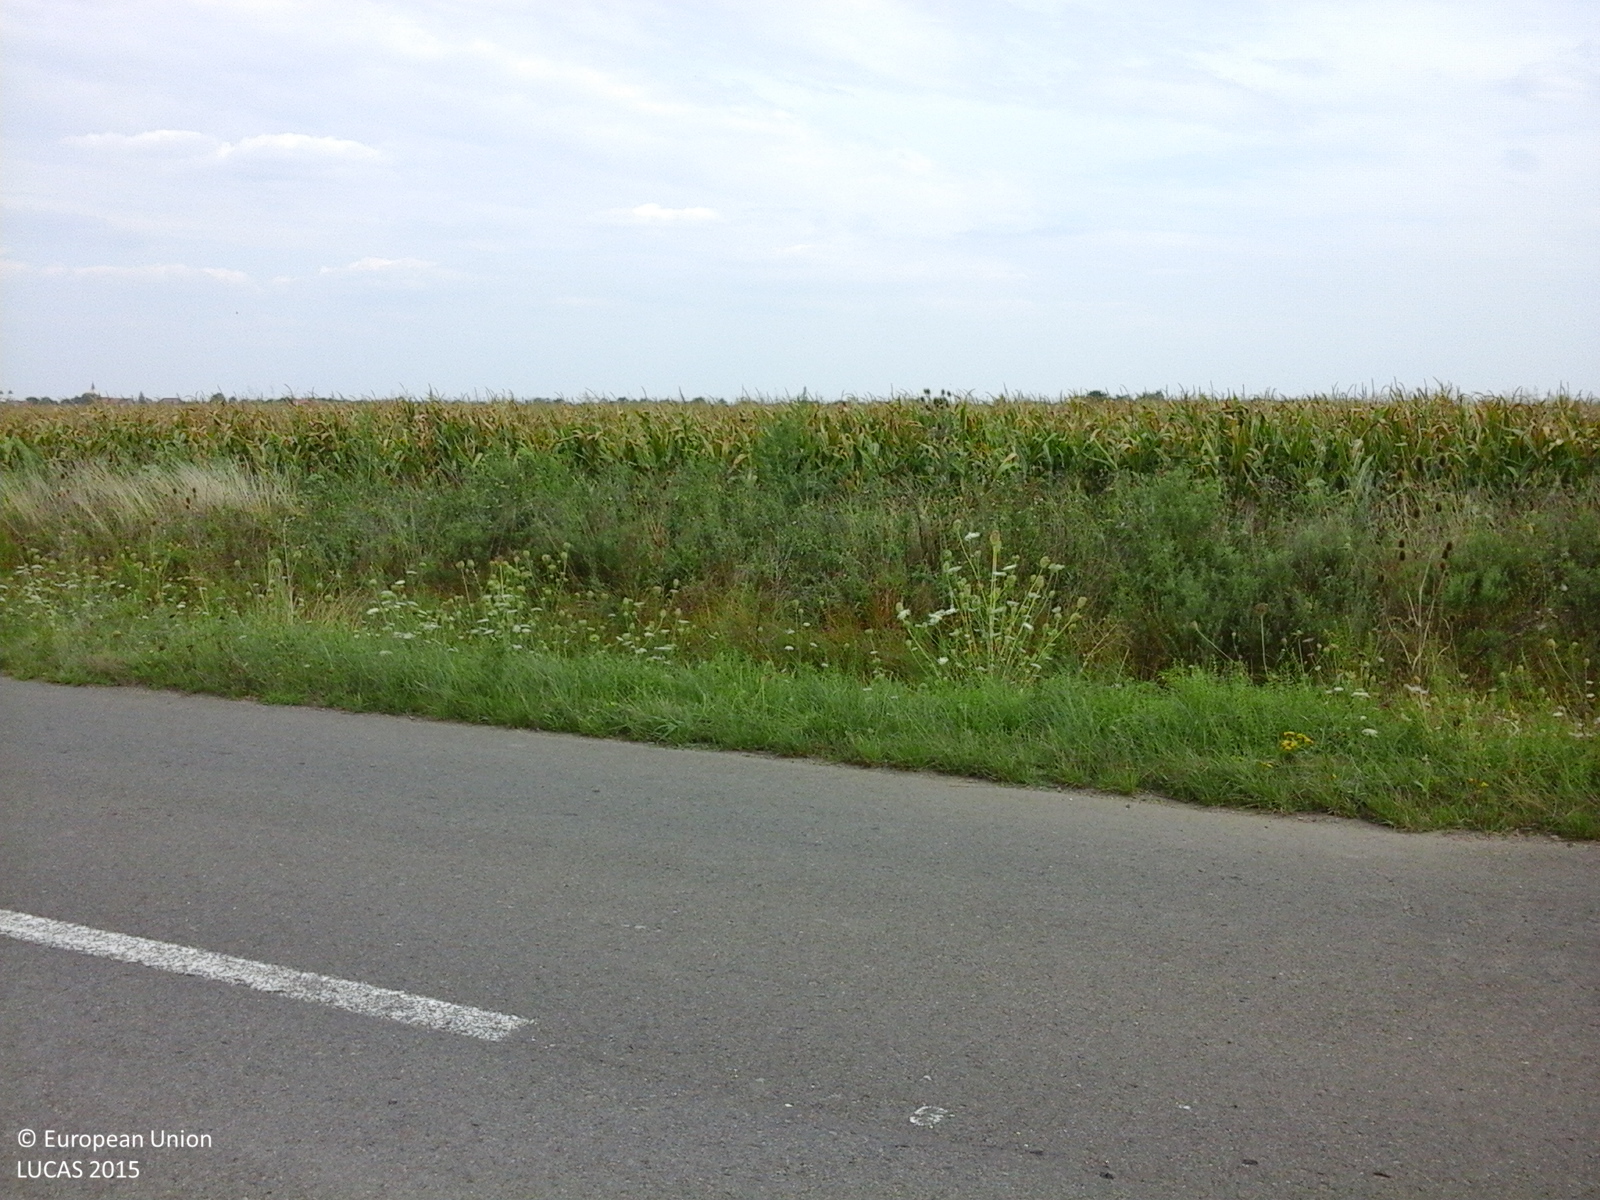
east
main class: Grassland
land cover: Grassland without tree/shrub cover
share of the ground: > 75 %
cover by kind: herbaceous plants 100 %
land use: Agriculture (excluding fallow land and kitchen gardens)
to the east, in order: Grassland without tree/shrub cover; Fences; Ditches and canals; Grass margins; Paved roads, cycling and walking lanes; Shruby margins; Ditches and canals; Shruby margins; Maize
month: August
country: RO
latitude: 46.2748
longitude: 21.1536
